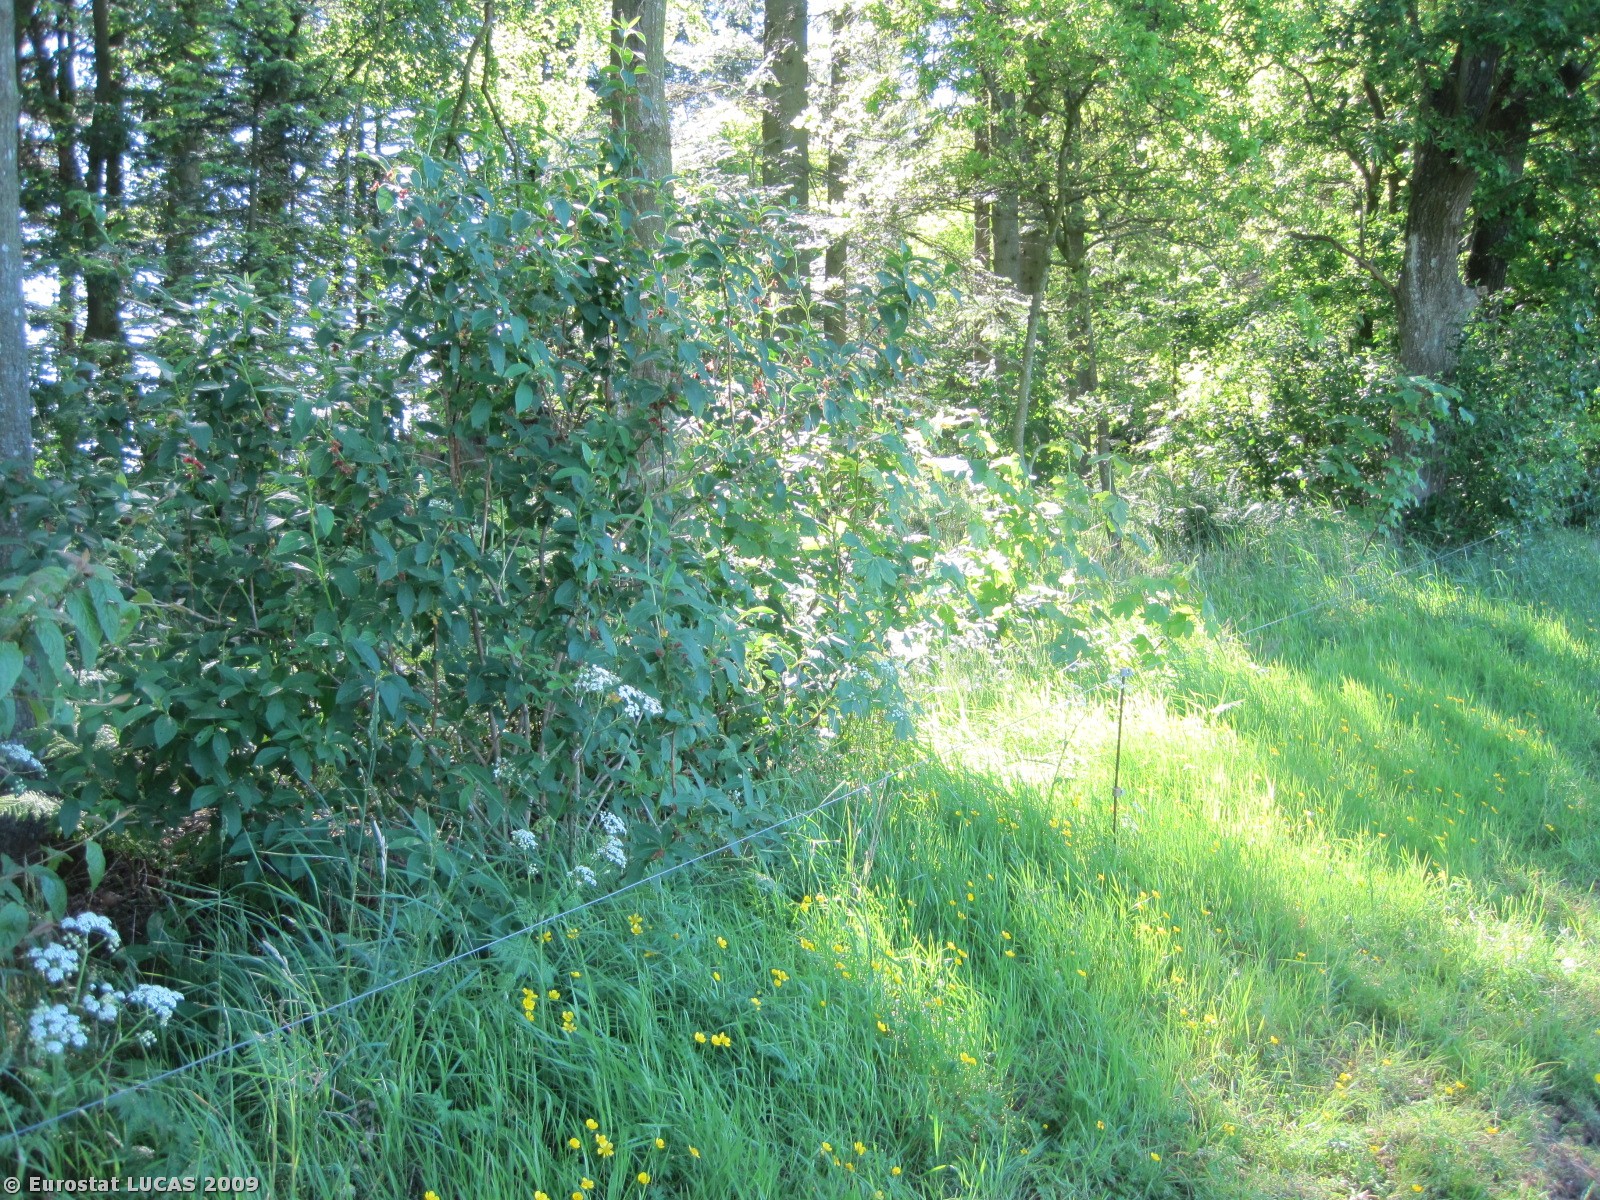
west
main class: Grassland
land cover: Grassland without tree/shrub cover
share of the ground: > 75 %
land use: Agriculture (excluding fallow land and kitchen gardens)
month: June
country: DK
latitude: 57.5181
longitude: 10.0833
